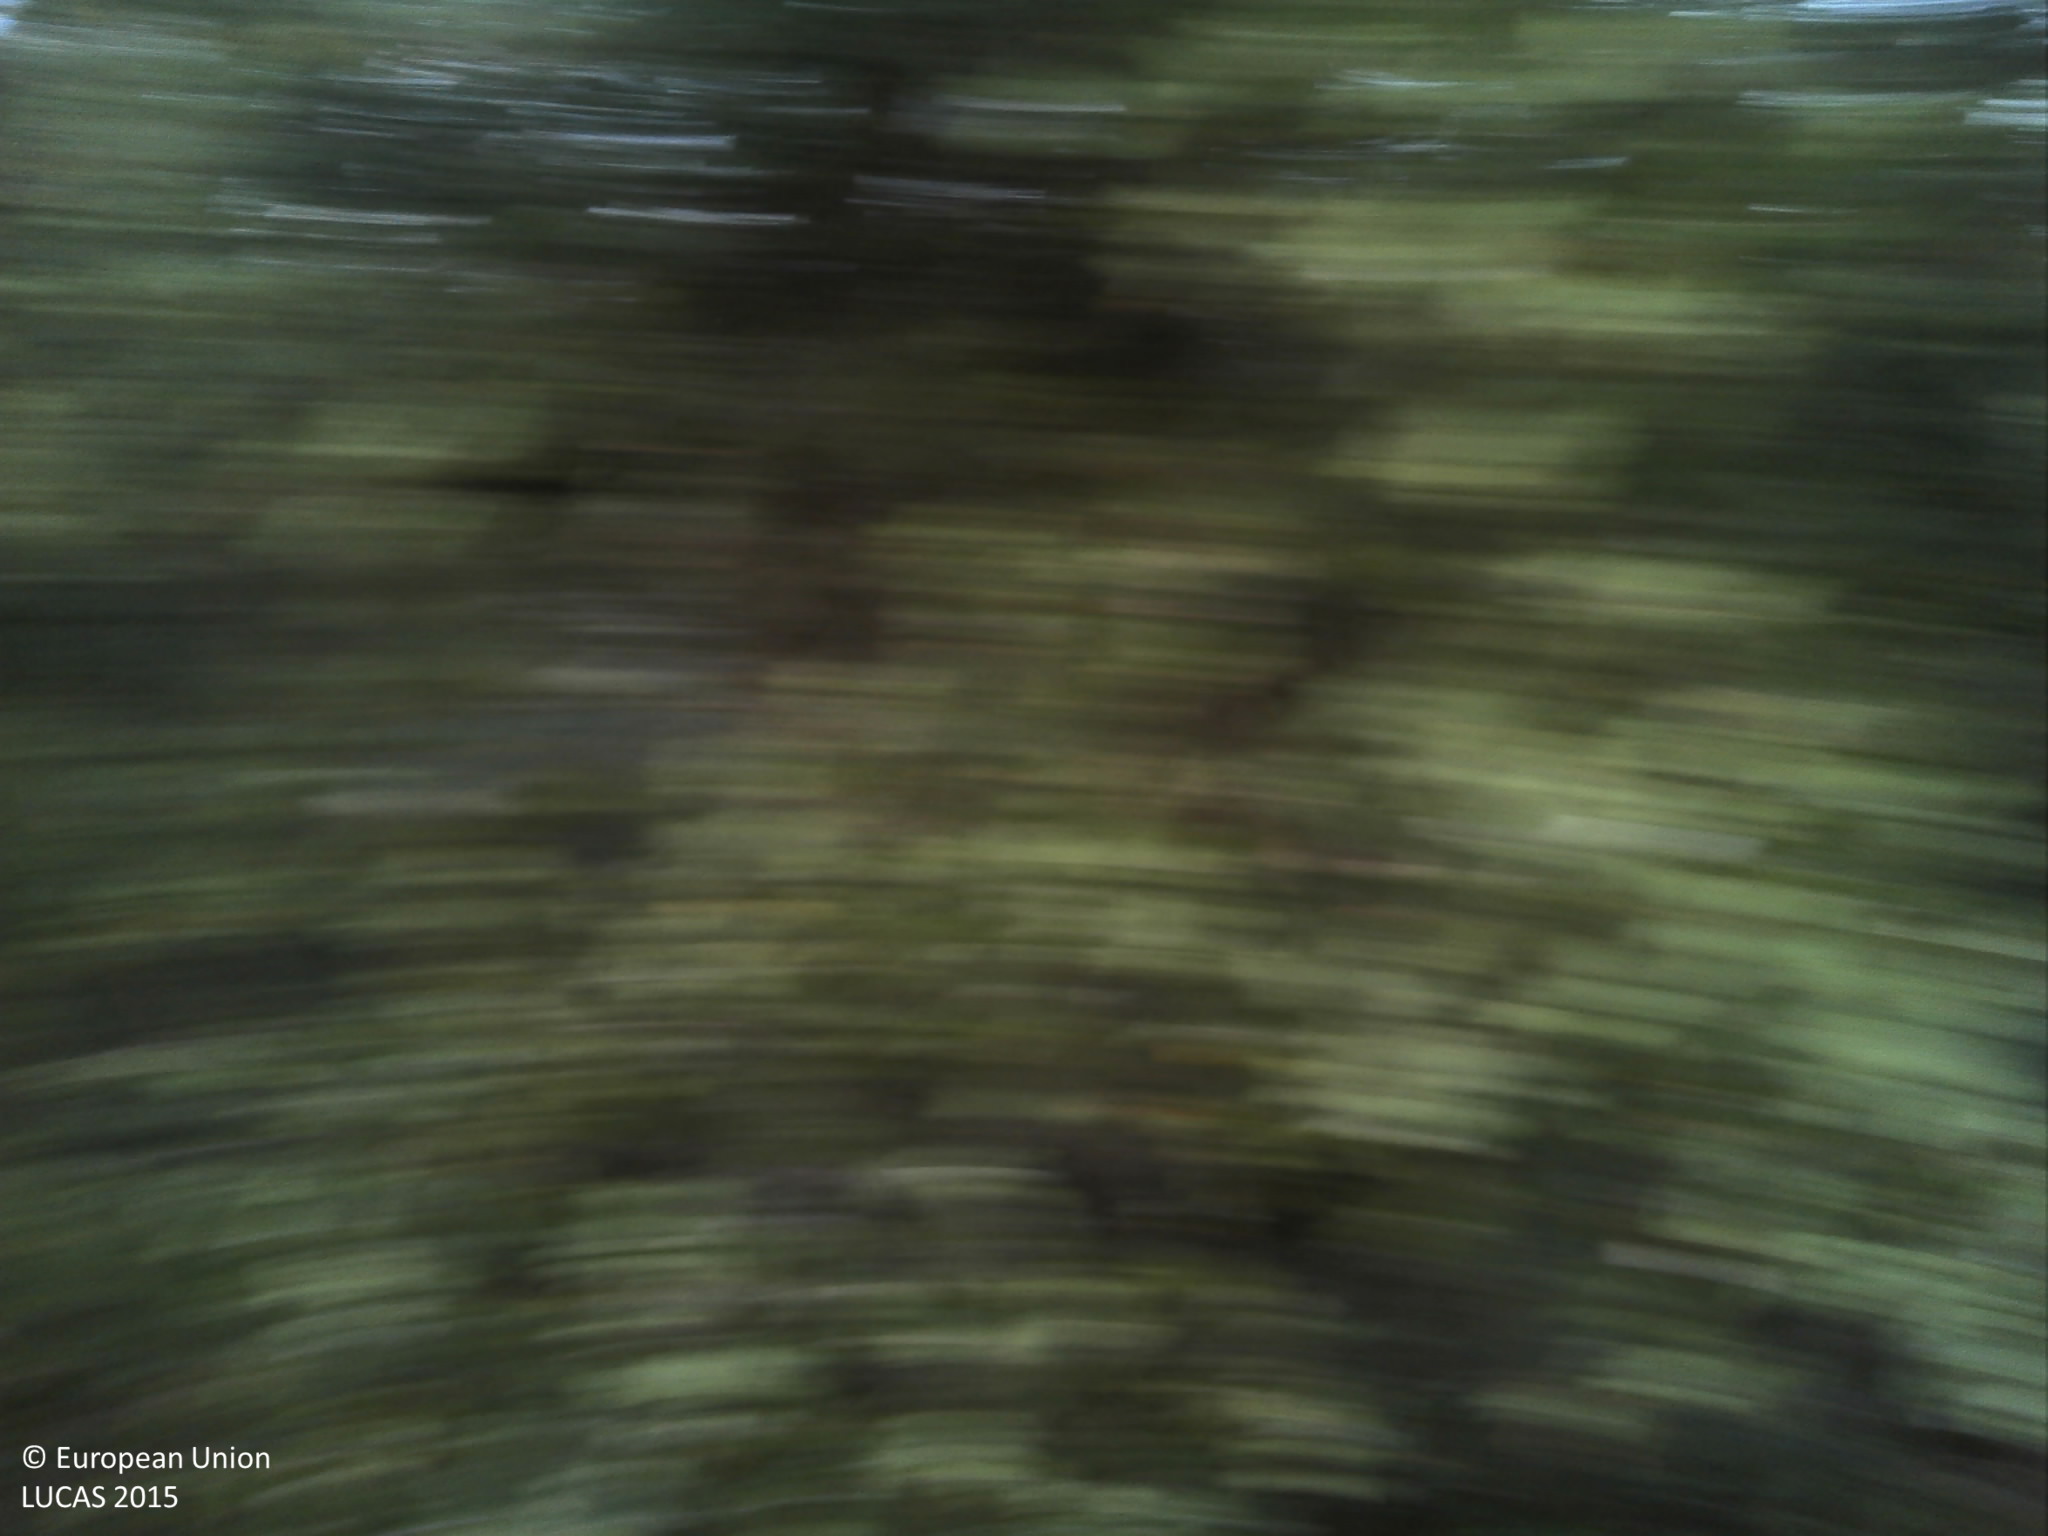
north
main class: Shrubland
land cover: Shrubland with sparse tree cover
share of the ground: > 75 %
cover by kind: shrubs 95 %, broadleaved forest trees 5 %
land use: Abandoned areas
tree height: > 5 m
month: May
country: PT
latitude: 40.6648
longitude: -7.3444
